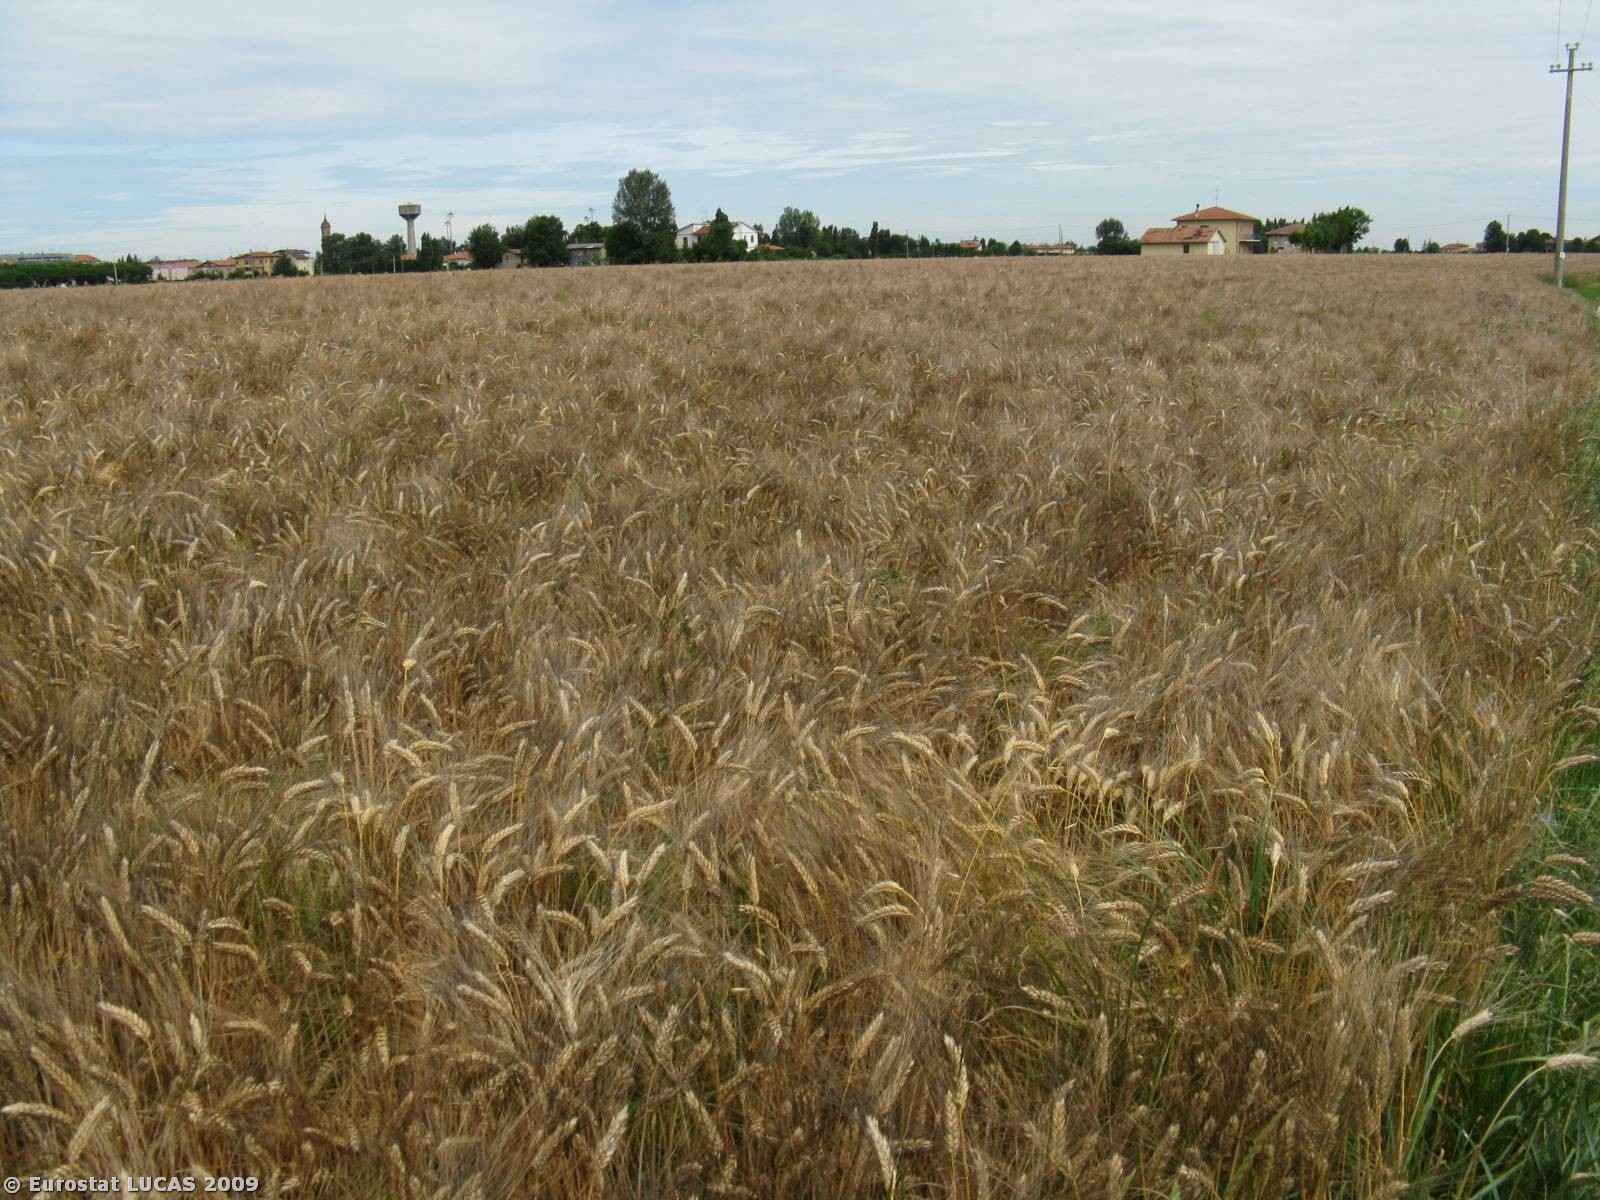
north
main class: Cropland
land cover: Durum wheat
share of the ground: > 75 %
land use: Agriculture (excluding fallow land and kitchen gardens)
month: June
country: IT
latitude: 44.4638
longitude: 11.6430
